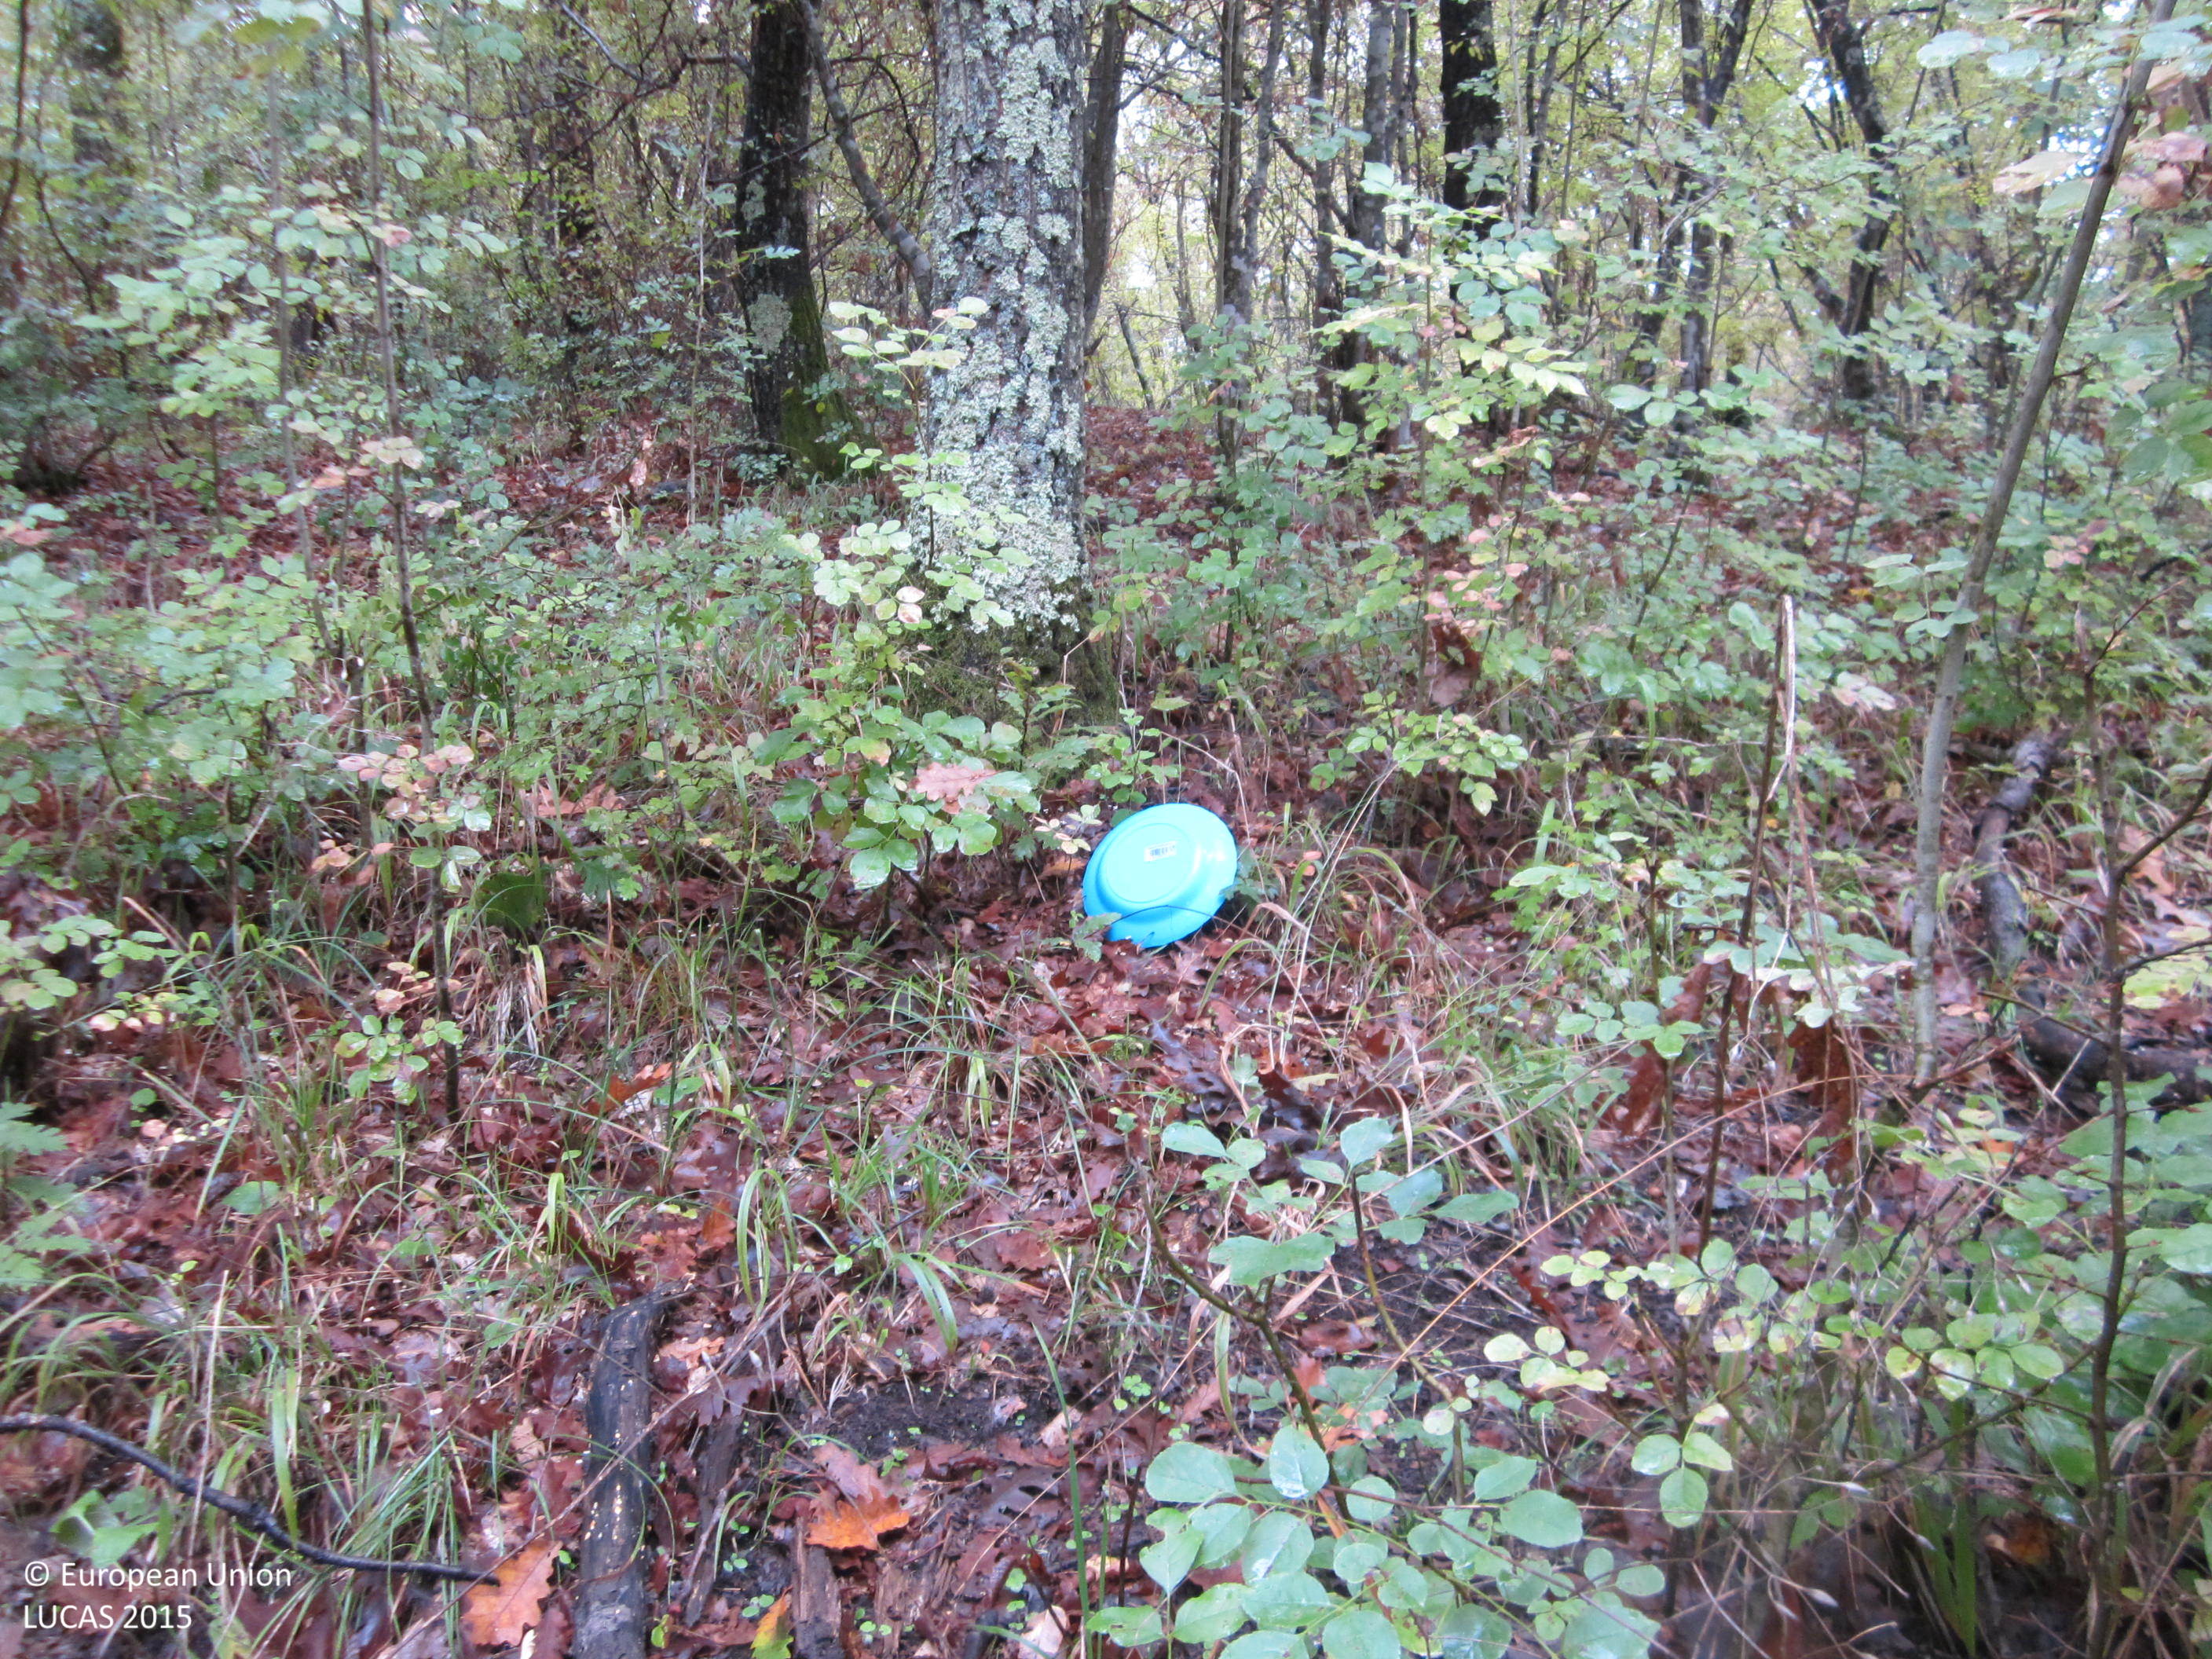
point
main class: Woodland
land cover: Broadleaved woodland
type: mesophytic deciduous forest
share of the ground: > 75 %
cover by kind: broadleaved forest trees 80 %, shrubs 10 %, herbaceous plants 10 %
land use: Forestry
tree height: > 5 m
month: October
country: BG
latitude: 42.3156
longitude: 27.1777
